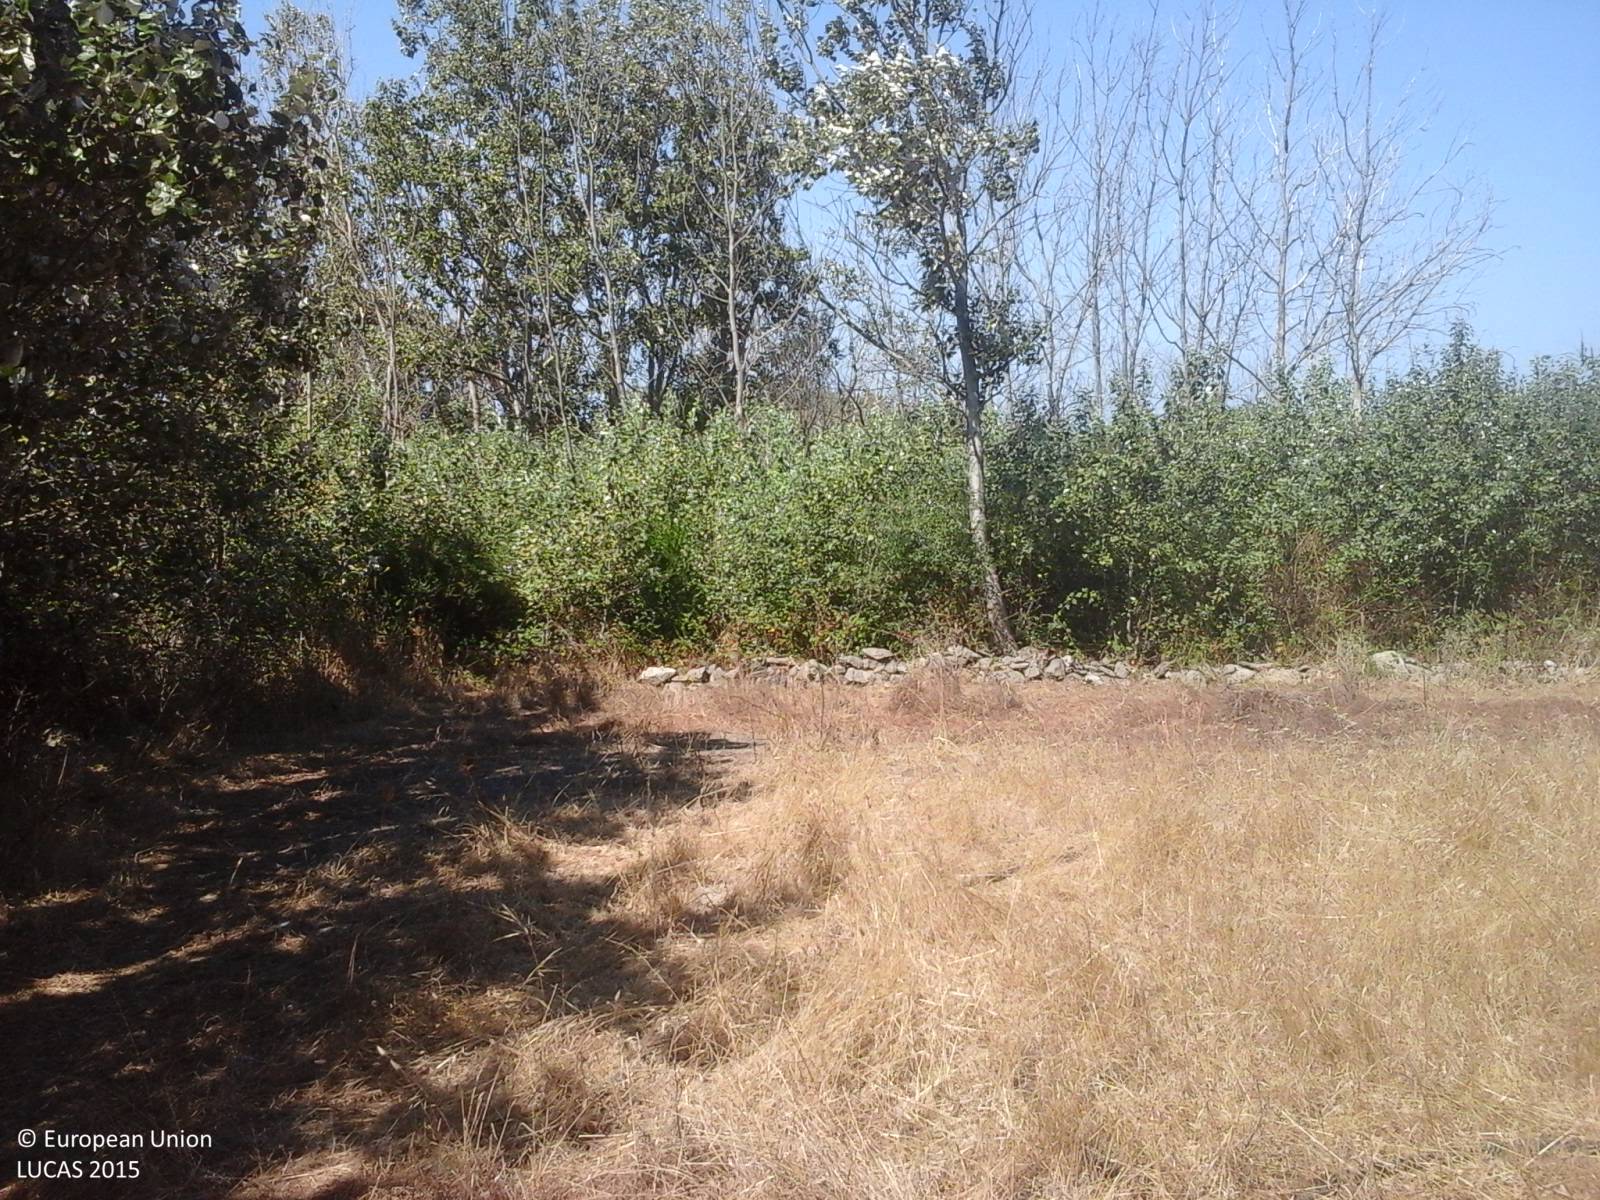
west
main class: Grassland
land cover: Spontaneously vegetated surfaces
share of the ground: > 75 %
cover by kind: herbaceous plants 85 %, unconsolidated bare surface 15 %
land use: Fallow land
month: July
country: IT
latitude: 39.2217
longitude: 8.3998
